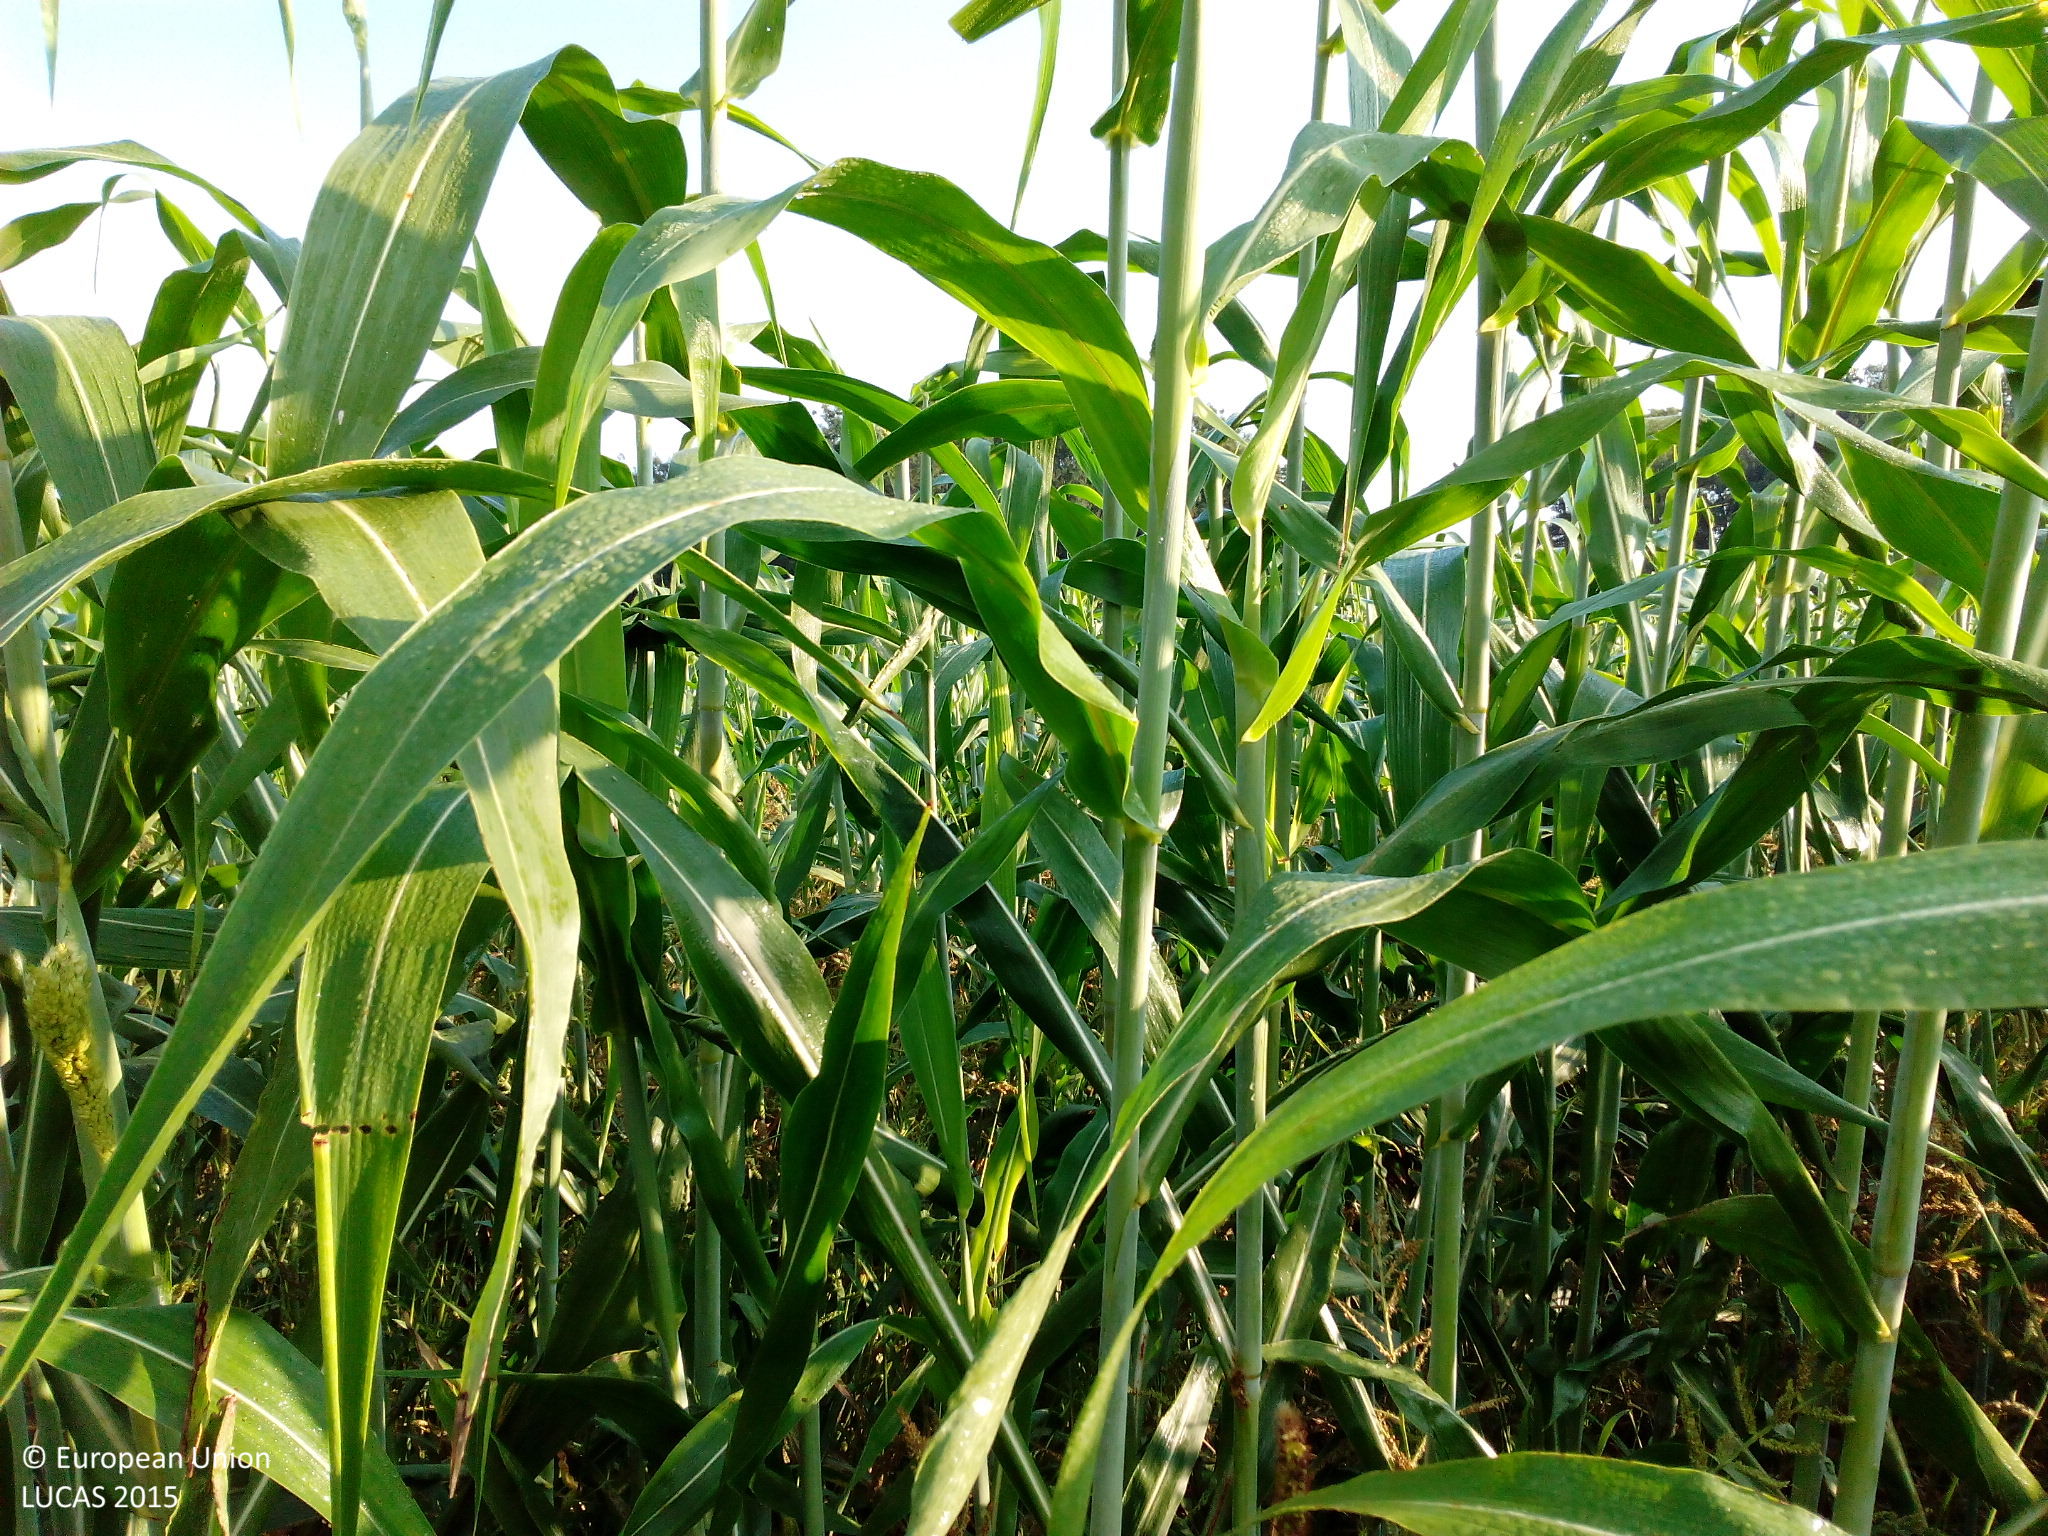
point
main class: Cropland
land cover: Maize
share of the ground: > 75 %
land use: Agriculture (excluding fallow land and kitchen gardens)
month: August
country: DE
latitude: 48.4930
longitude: 10.3111
